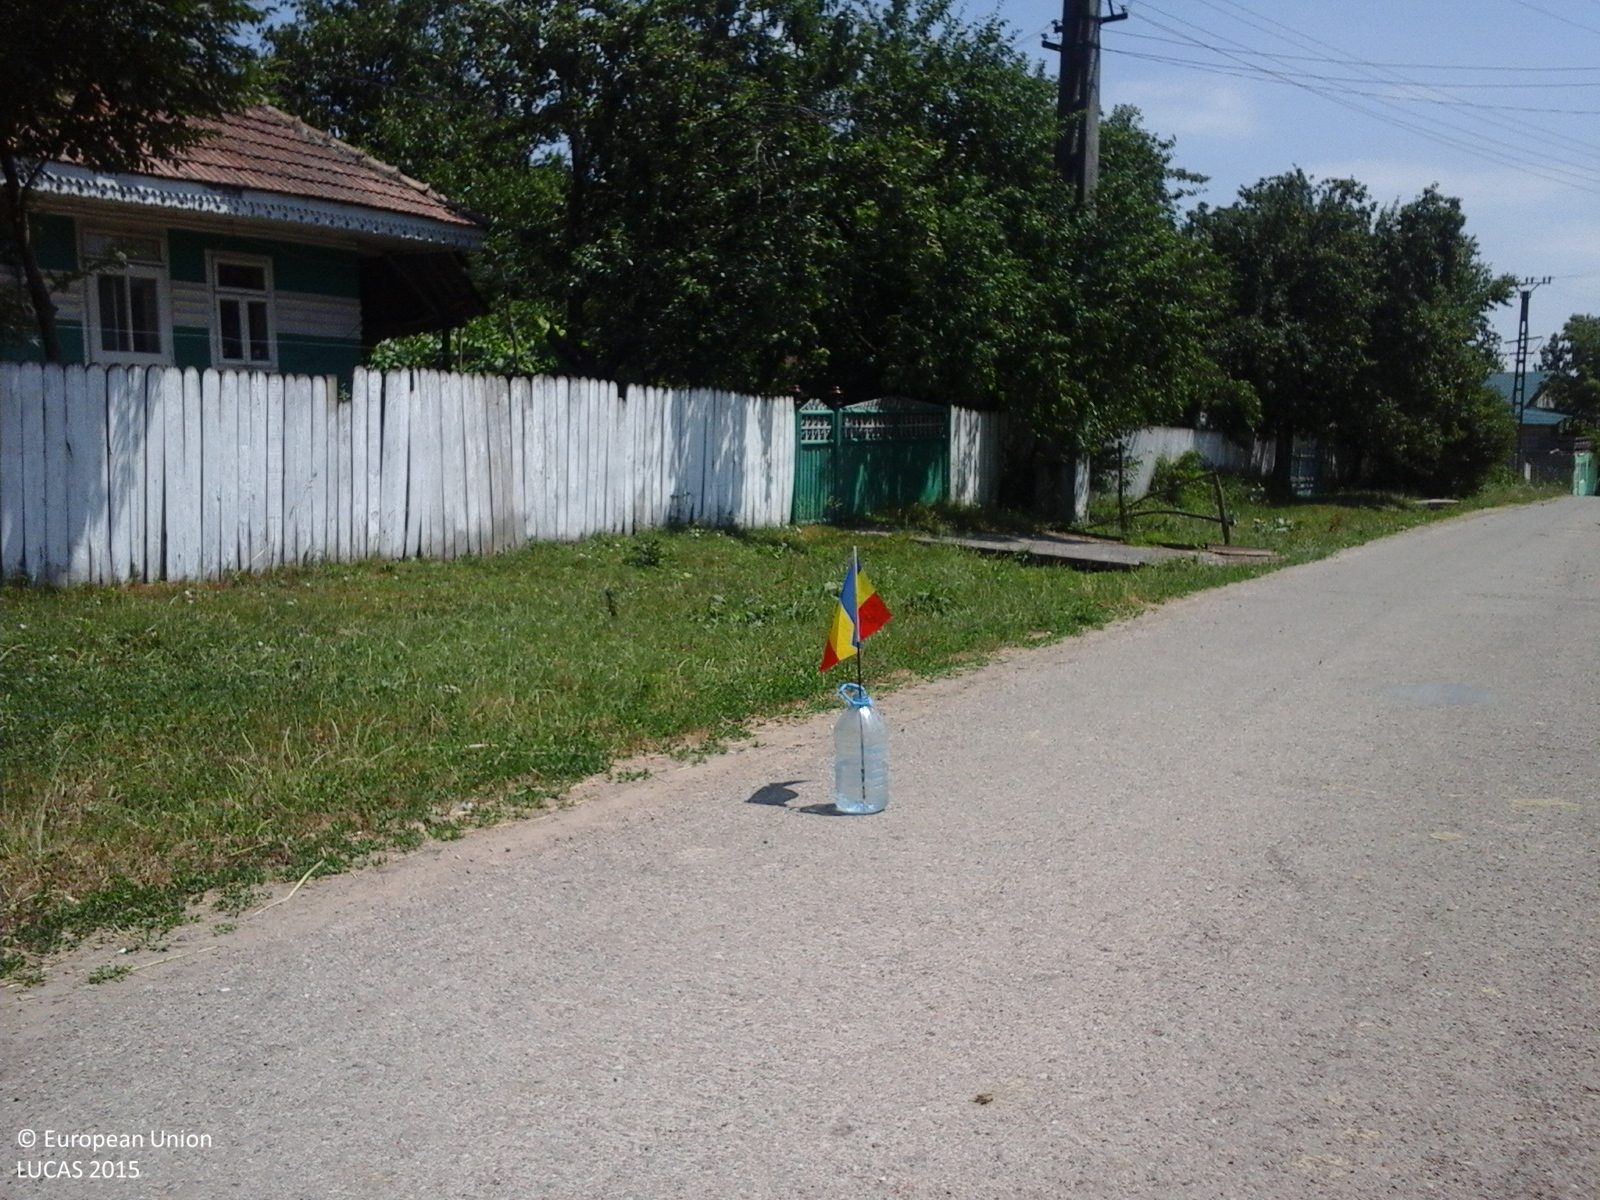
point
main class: Cropland
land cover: Cherry fruit
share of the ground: 50 - 75 %
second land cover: Grassland without tree/shrub cover
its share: > 75 %
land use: Kitchen garden
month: June
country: RO
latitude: 46.8532
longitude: 27.8972
